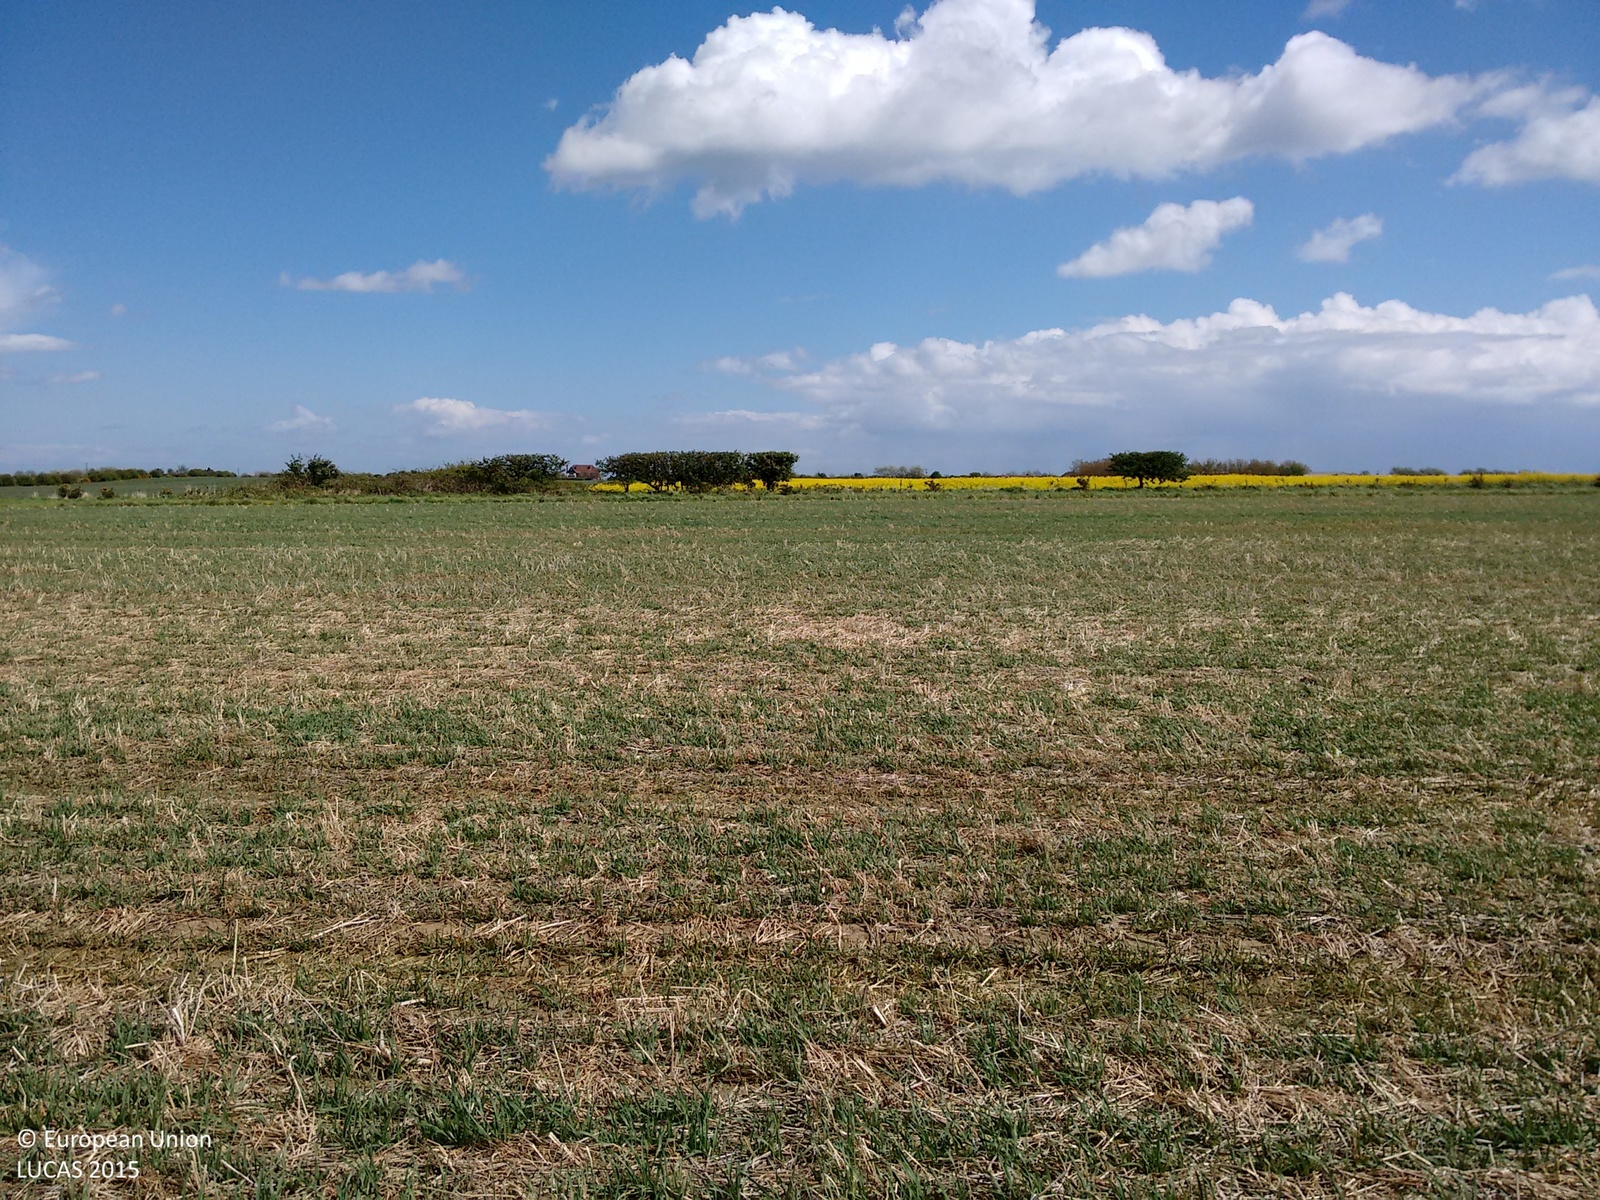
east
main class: Cropland
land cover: Barley
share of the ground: 25 - 50 %
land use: Agriculture (excluding fallow land and kitchen gardens)
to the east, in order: Barley; Grassland without tree/shrub cover; Rape and turnip rape
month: May
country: GB
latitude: 53.8630
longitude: -0.1446
